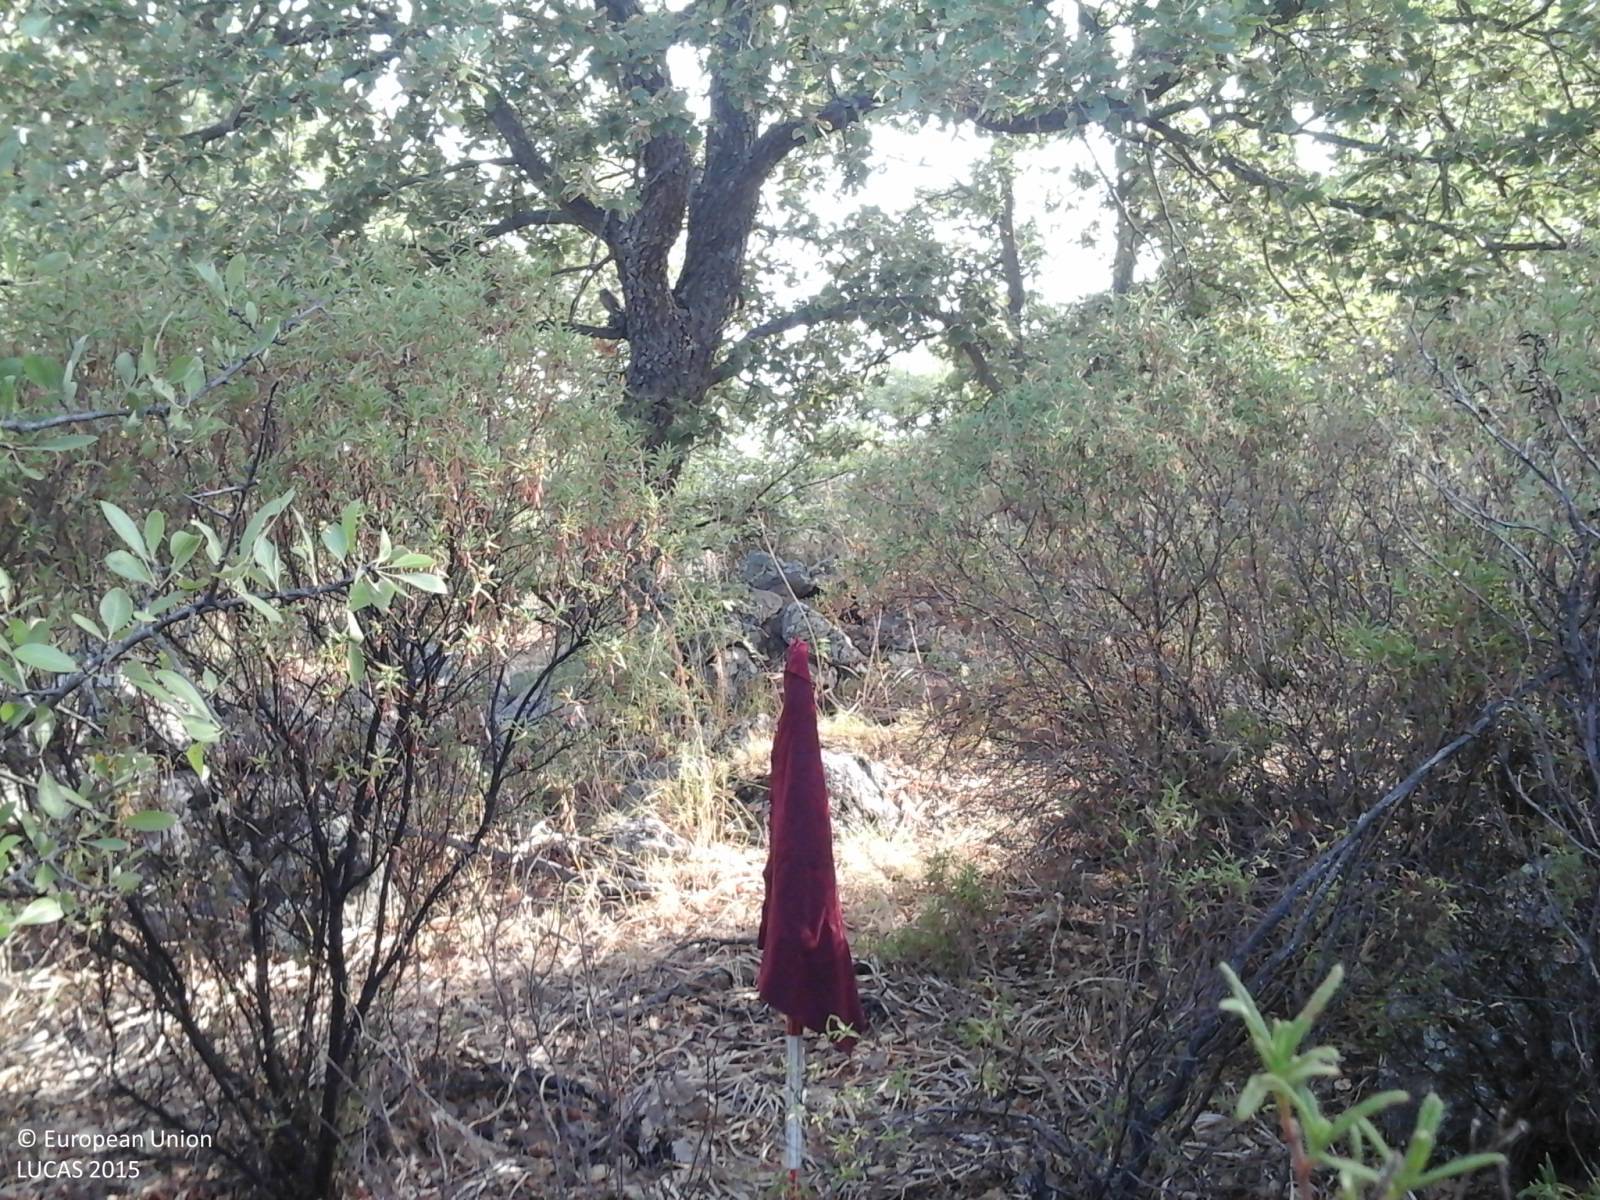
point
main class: Woodland
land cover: Broadleaved woodland
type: broadleaved evergreen forest
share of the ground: 25 - 50 %
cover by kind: herbaceous plants 45 %, broadleaved forest trees 30 %, shrubs 25 %
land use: Semi-natural and natural areas not in use
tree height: > 5 m
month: July
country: IT
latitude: 40.4420
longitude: 8.8857
